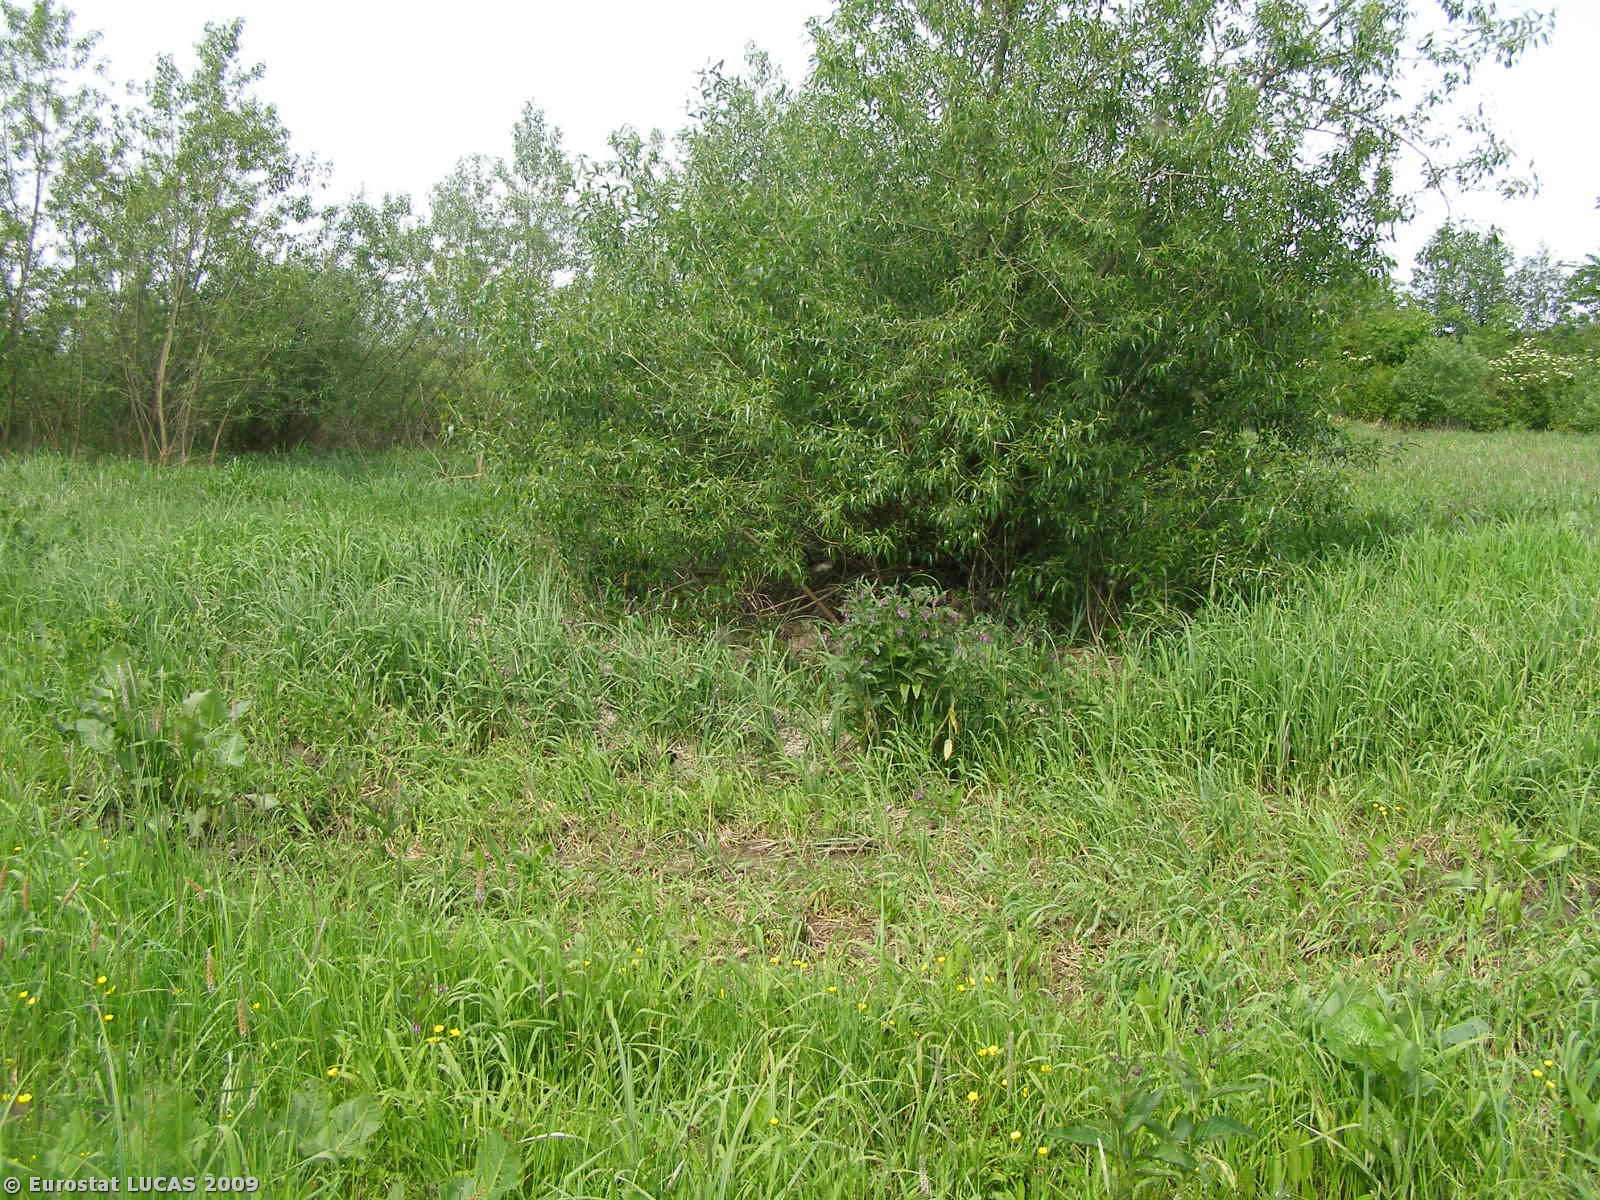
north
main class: Grassland
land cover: Grassland without tree/shrub cover
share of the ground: > 75 %
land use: Agriculture (excluding fallow land and kitchen gardens)
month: May
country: PL
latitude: 51.1399
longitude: 23.8554
